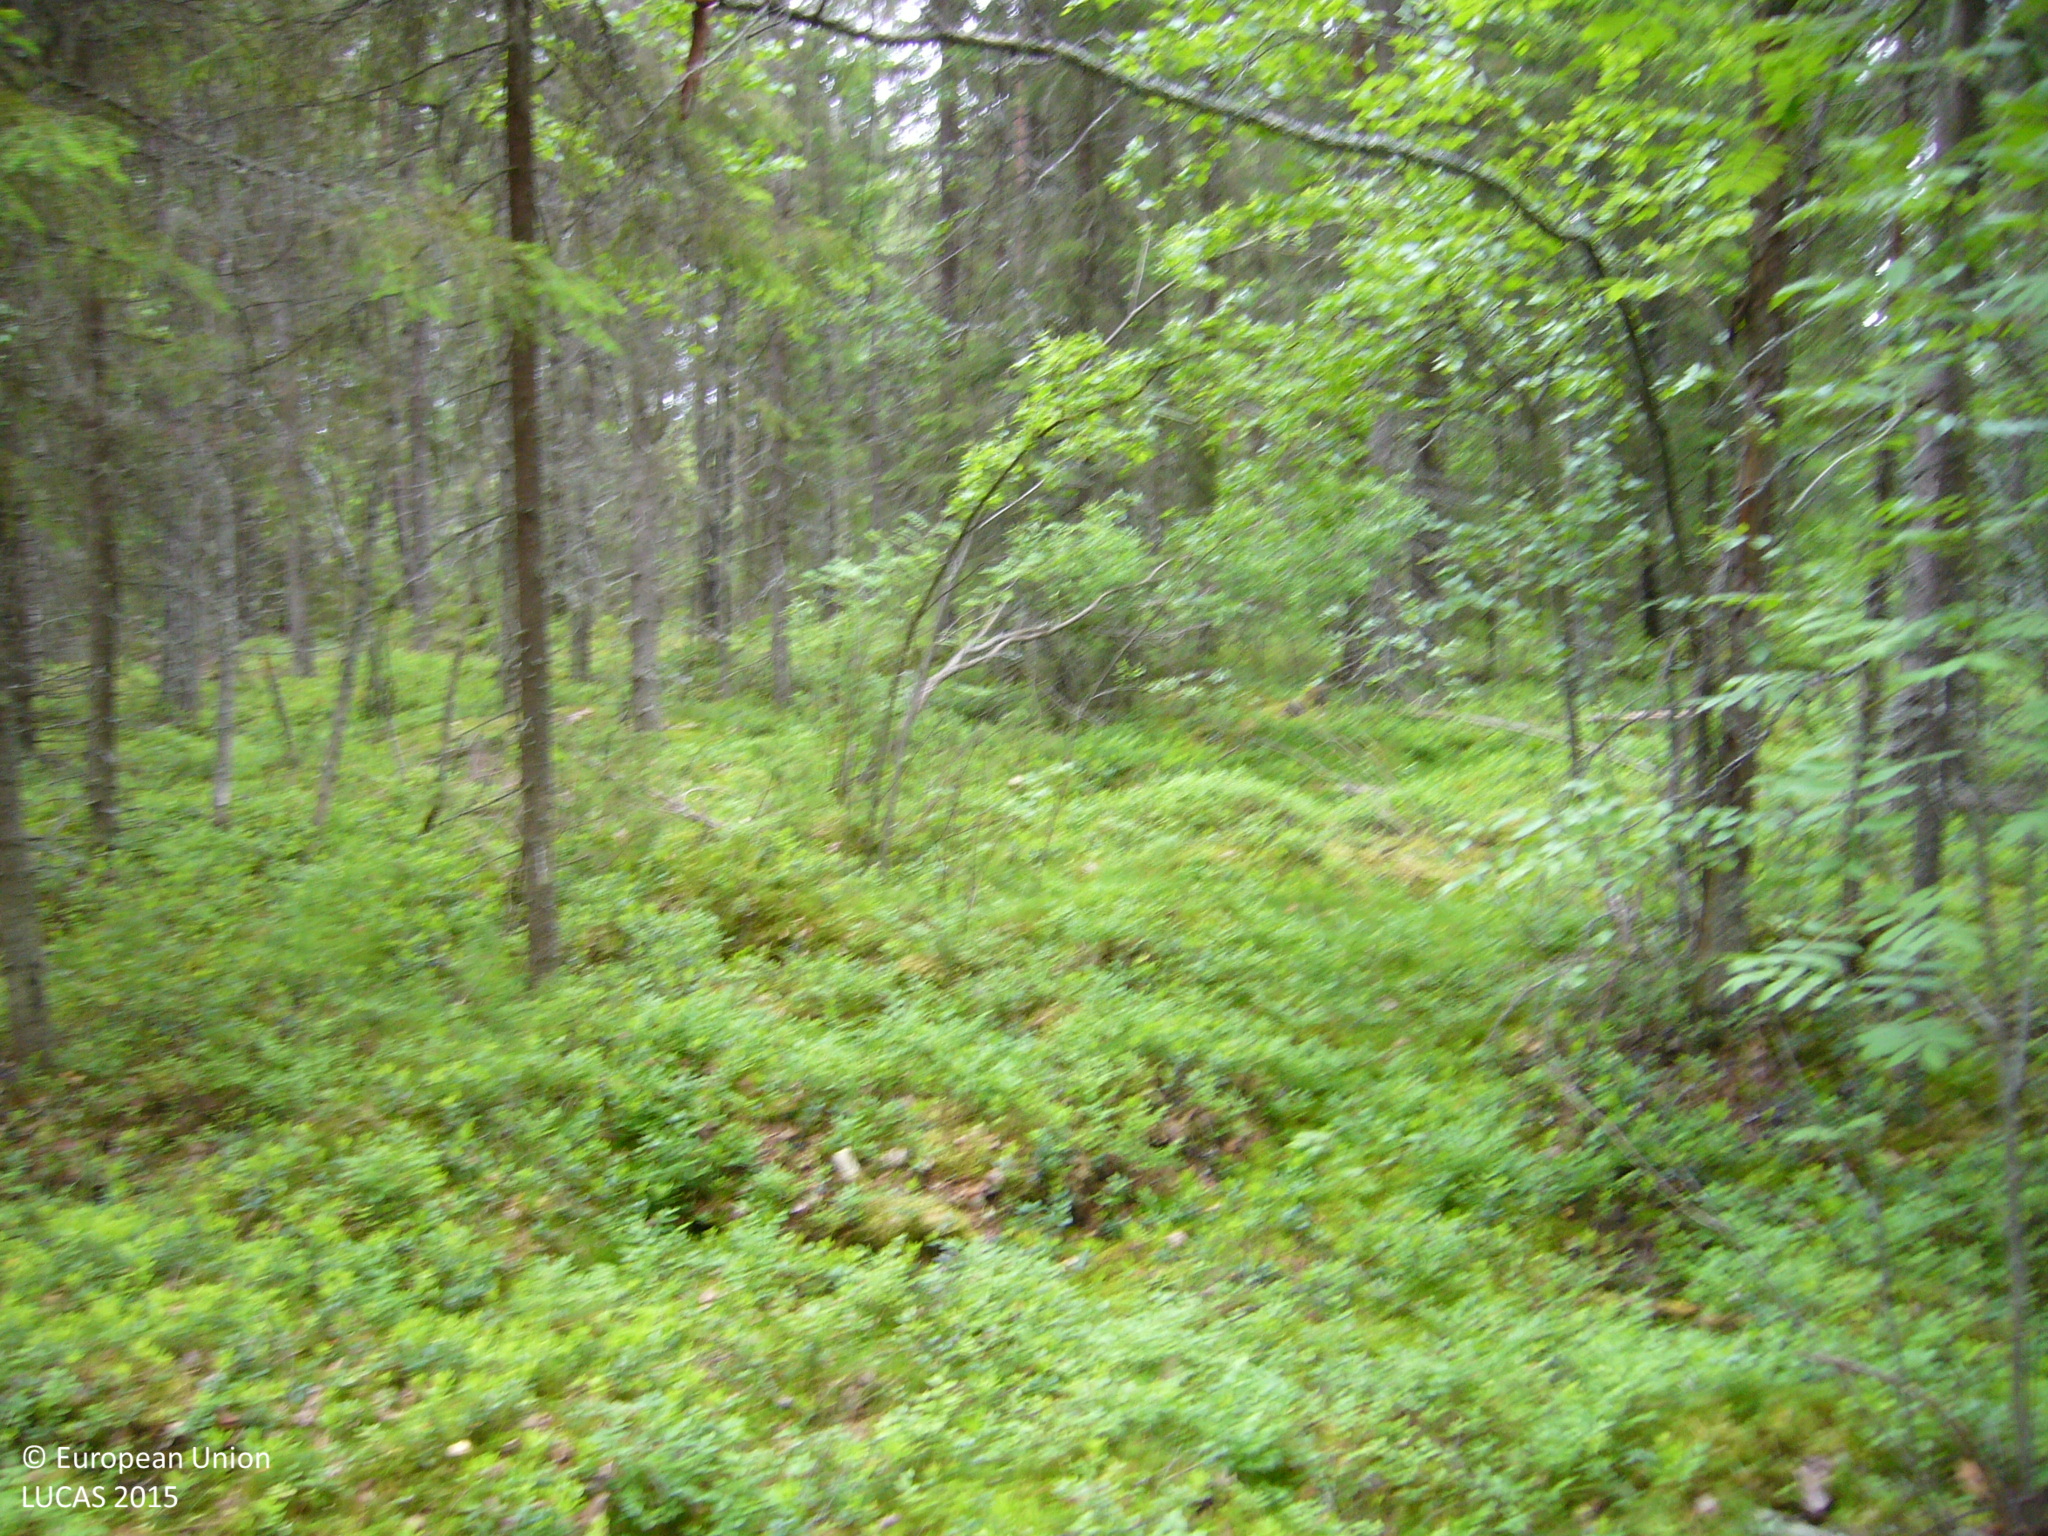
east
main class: Woodland
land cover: Other mixed woodland
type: boreal forest
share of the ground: > 75 %
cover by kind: coniferous forest trees 45 %, broadleaved forest trees 35 %, shrubs 20 %
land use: Forestry
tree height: > 5 m
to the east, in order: Other mixed woodland; Pine dominated mixed woodland; Ditches and canals; Grass margins; Temporary grasslands; Grass margins; Ditches and canals; Dry stone walls; Other mixed woodland; Ditches and canals; Other mixed woodland; Spruce dominated mixed woodland
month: July
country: FI
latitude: 63.3917
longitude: 26.1894
